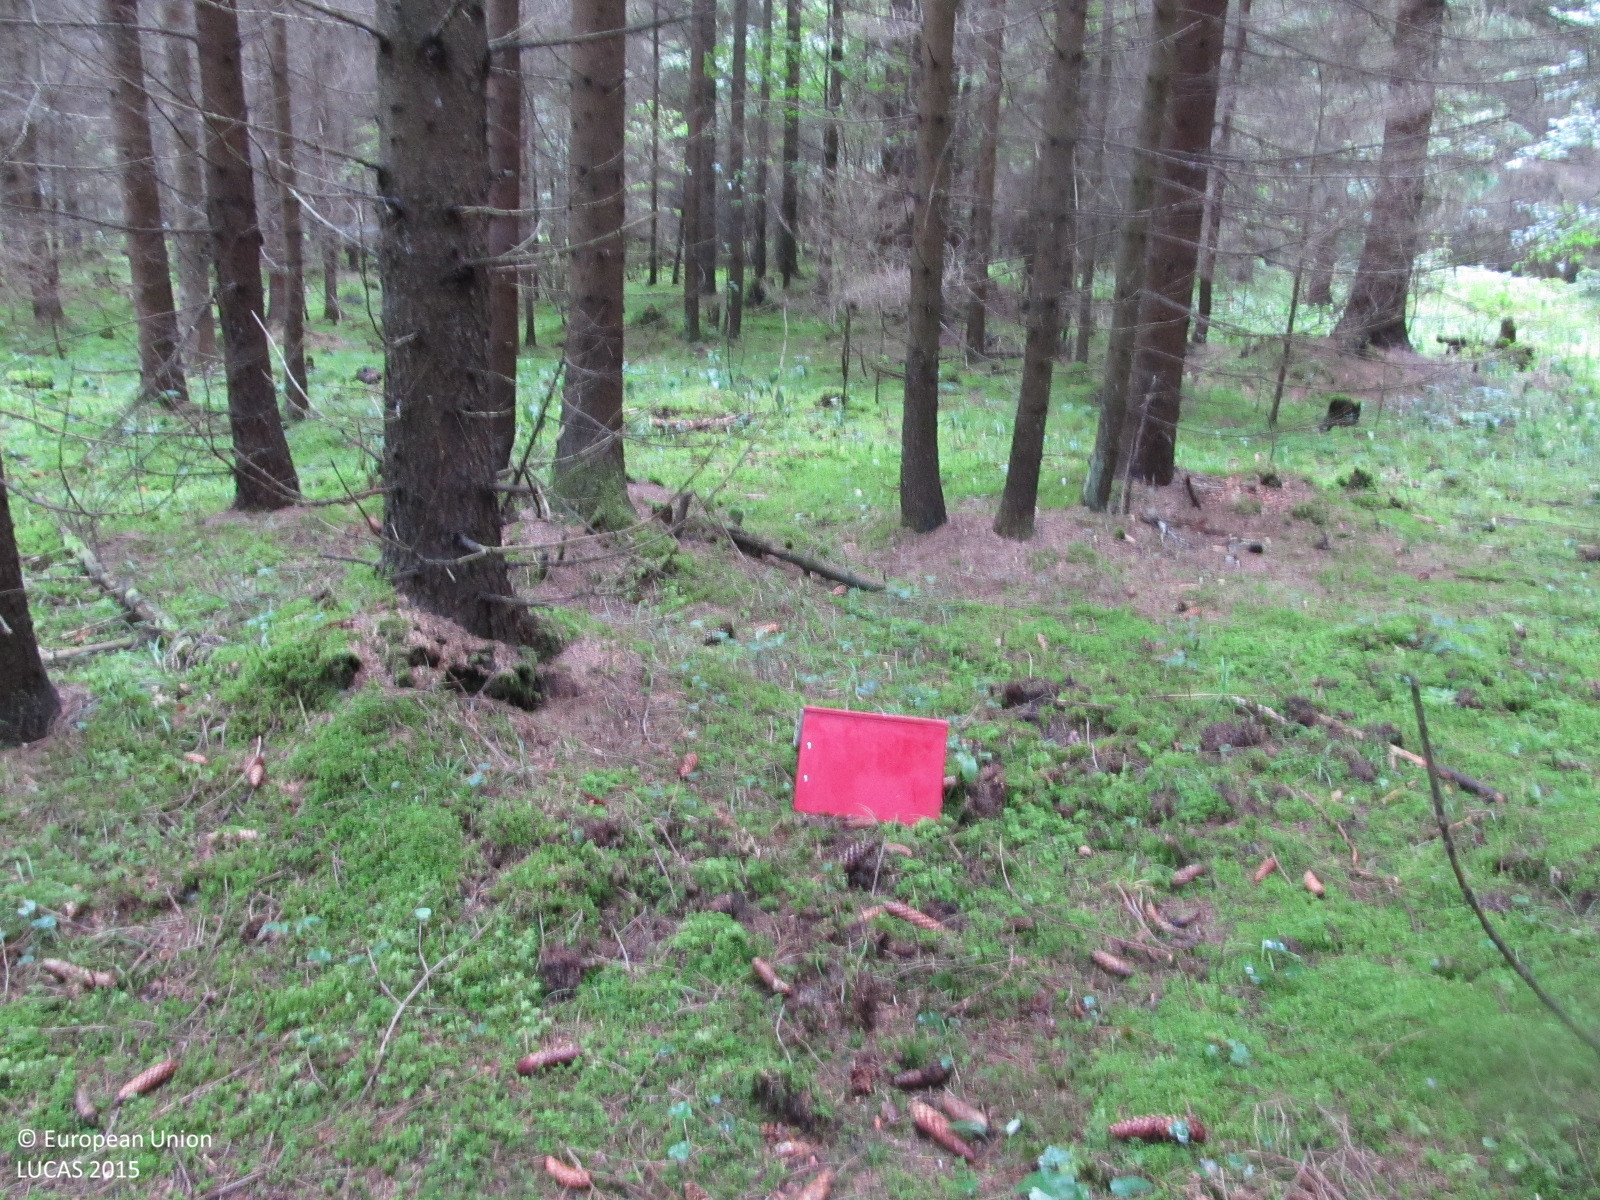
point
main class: Woodland
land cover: Spruce dominated coniferous woodland
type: hemiboreal forest and nemoral coniferous forest and mixed broadleaved-coniferous forest
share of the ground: > 75 %
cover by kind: coniferous forest trees 80 %, lichens and mosses 15 %, herbaceous plants 5 %
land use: Forestry
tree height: > 5 m
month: September
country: LT
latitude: 56.0648
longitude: 23.2262
